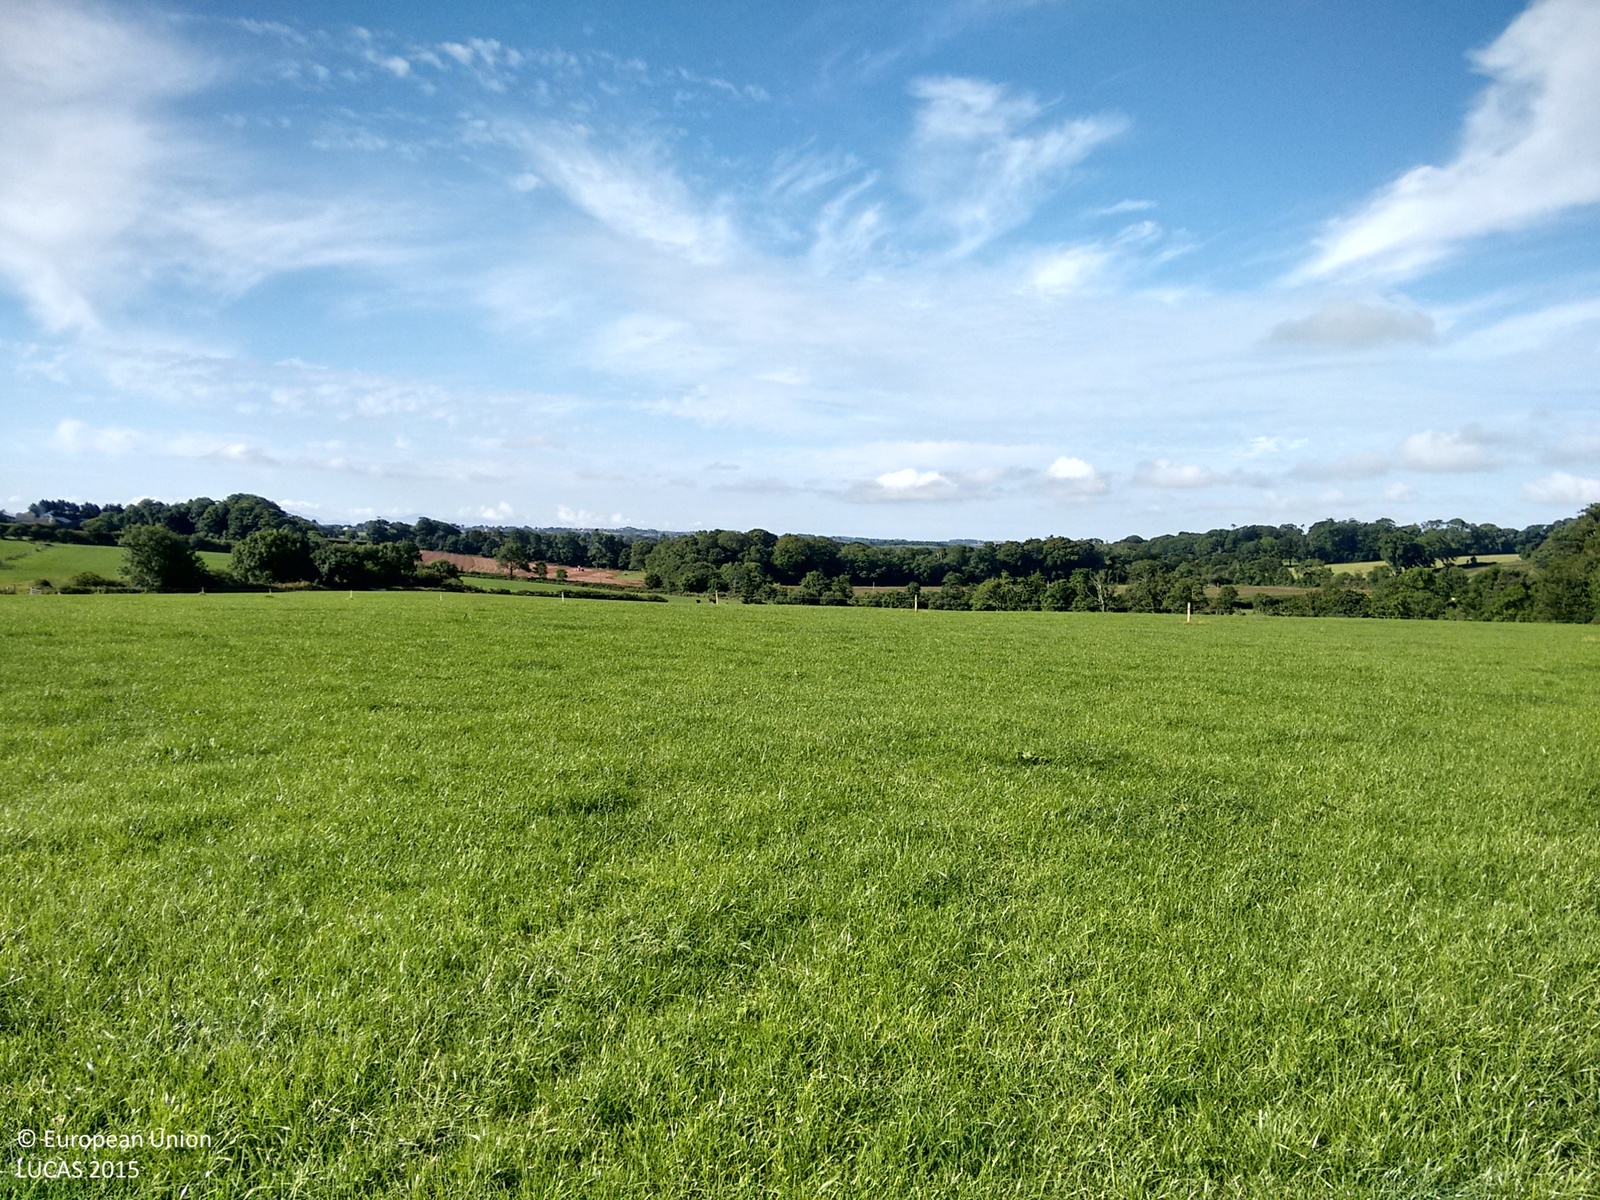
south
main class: Grassland
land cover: Grassland without tree/shrub cover
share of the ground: > 75 %
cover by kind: herbaceous plants 100 %
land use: Agriculture (excluding fallow land and kitchen gardens)
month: August
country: GB
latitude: 53.2955
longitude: -4.3088
